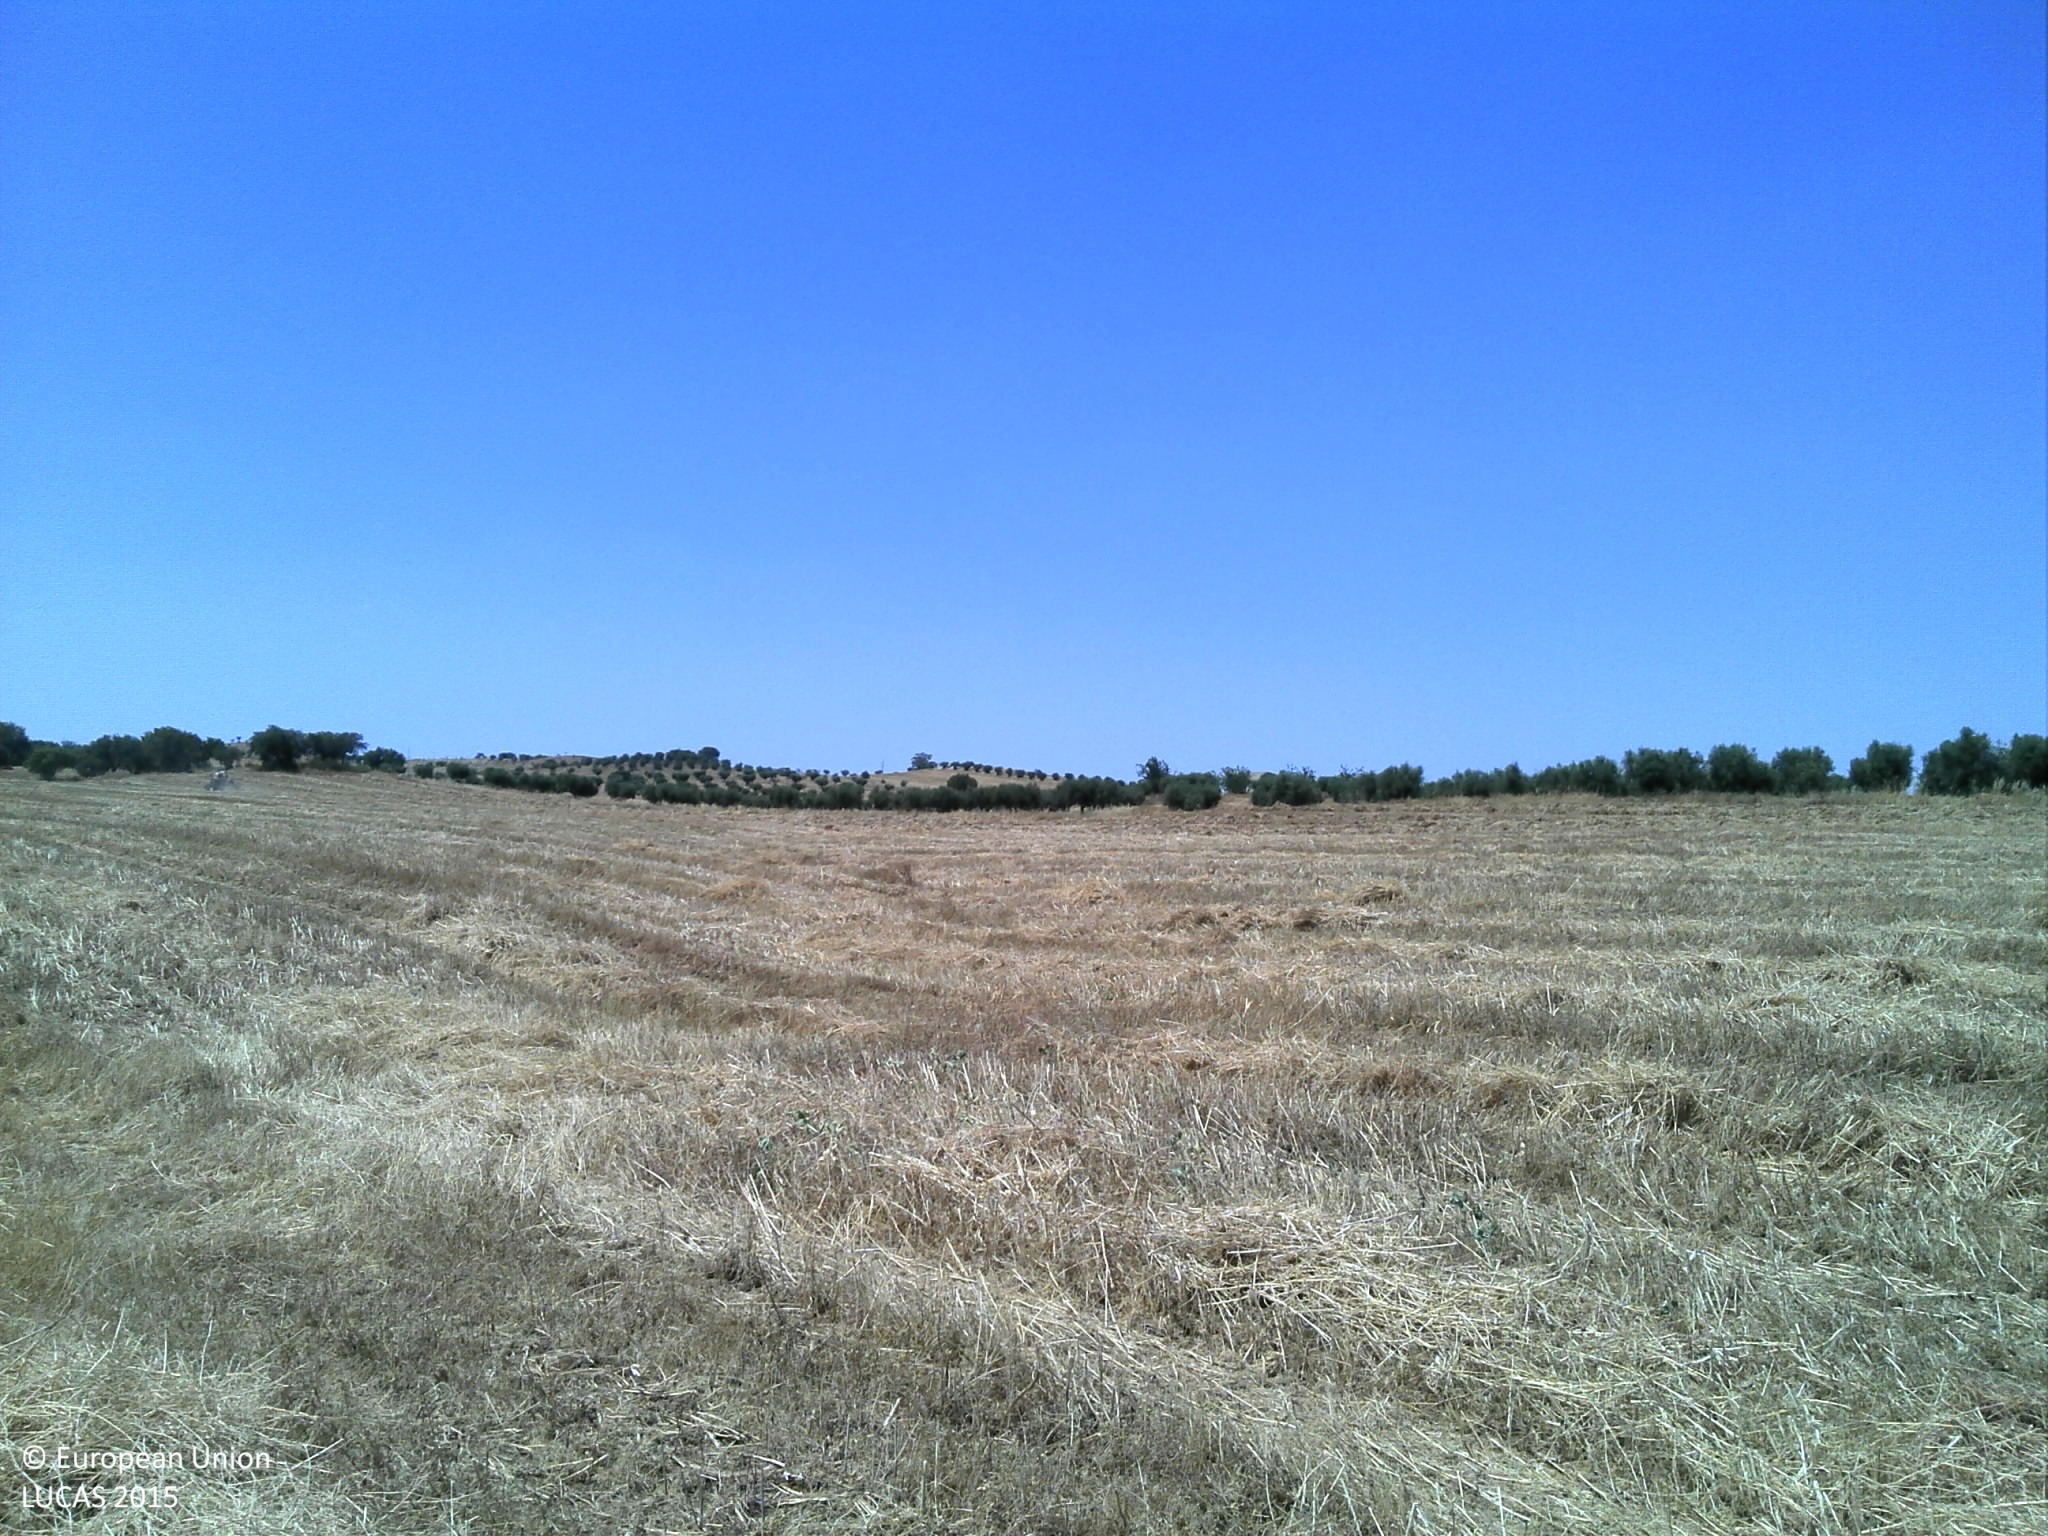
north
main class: Cropland
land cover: Other leguminous and mixtures for fodder
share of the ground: < 10 %
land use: Agriculture (excluding fallow land and kitchen gardens)
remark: Harvested field
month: June
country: PT
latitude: 38.2648
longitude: -7.9441
